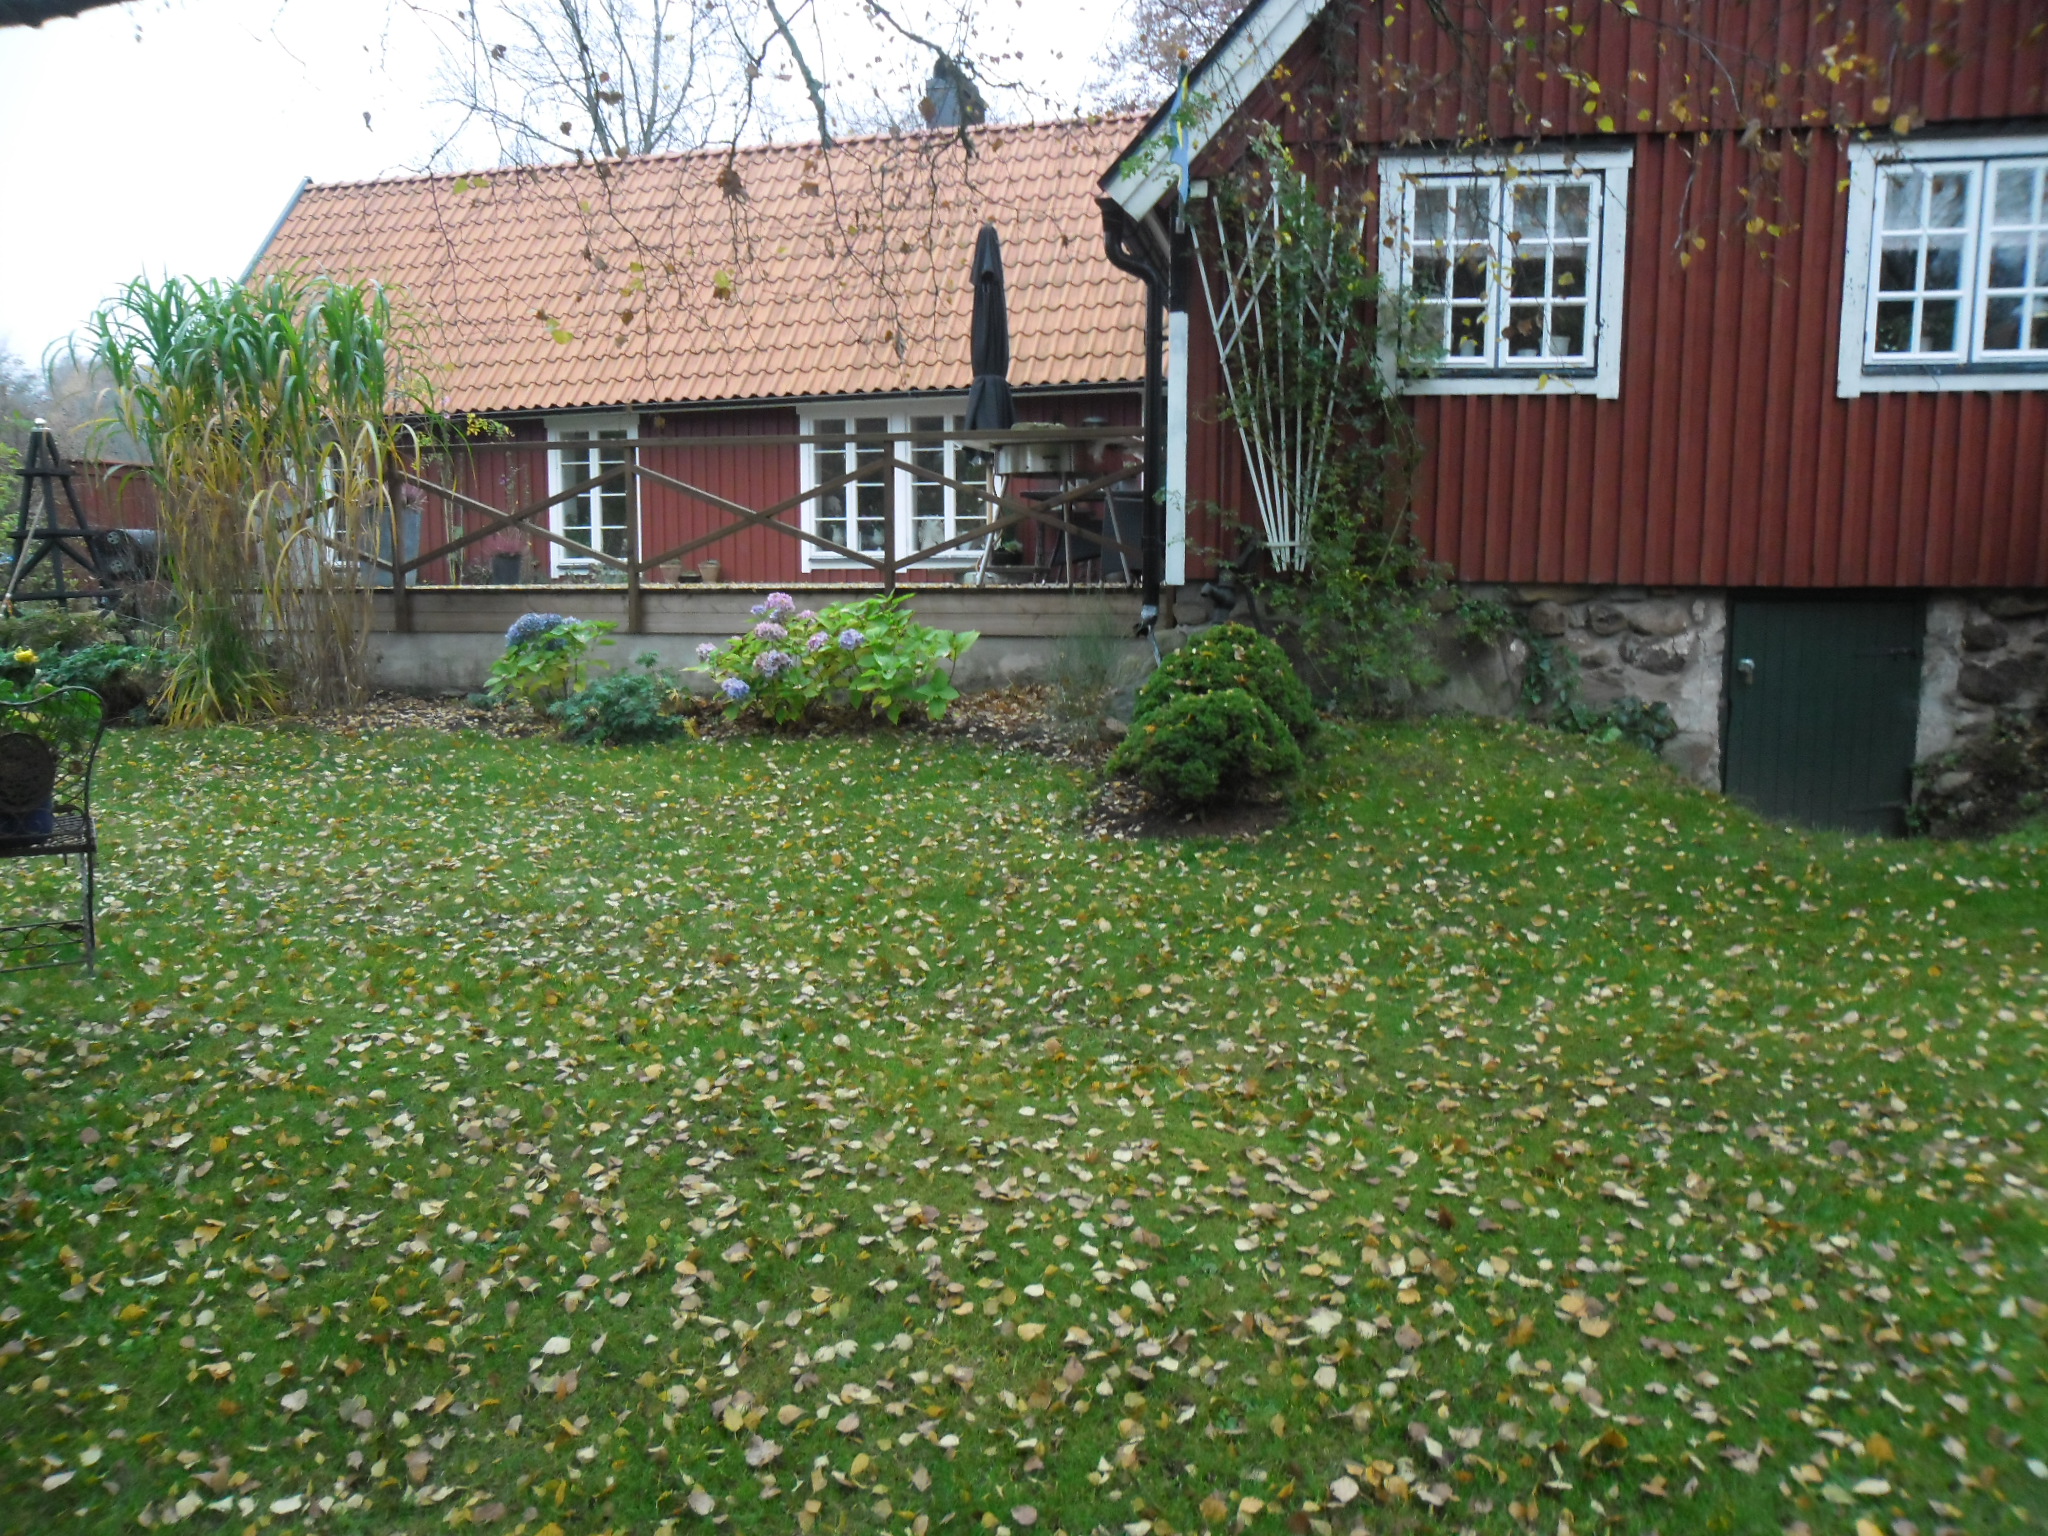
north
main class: Woodland
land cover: Spruce dominated mixed woodland
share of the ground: 50 - 75 %
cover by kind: coniferous forest trees 40 %, herbaceous plants 40 %, broadleaved forest trees 20 %
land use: Residential
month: November
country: SE
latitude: 56.3538
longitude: 12.8617
